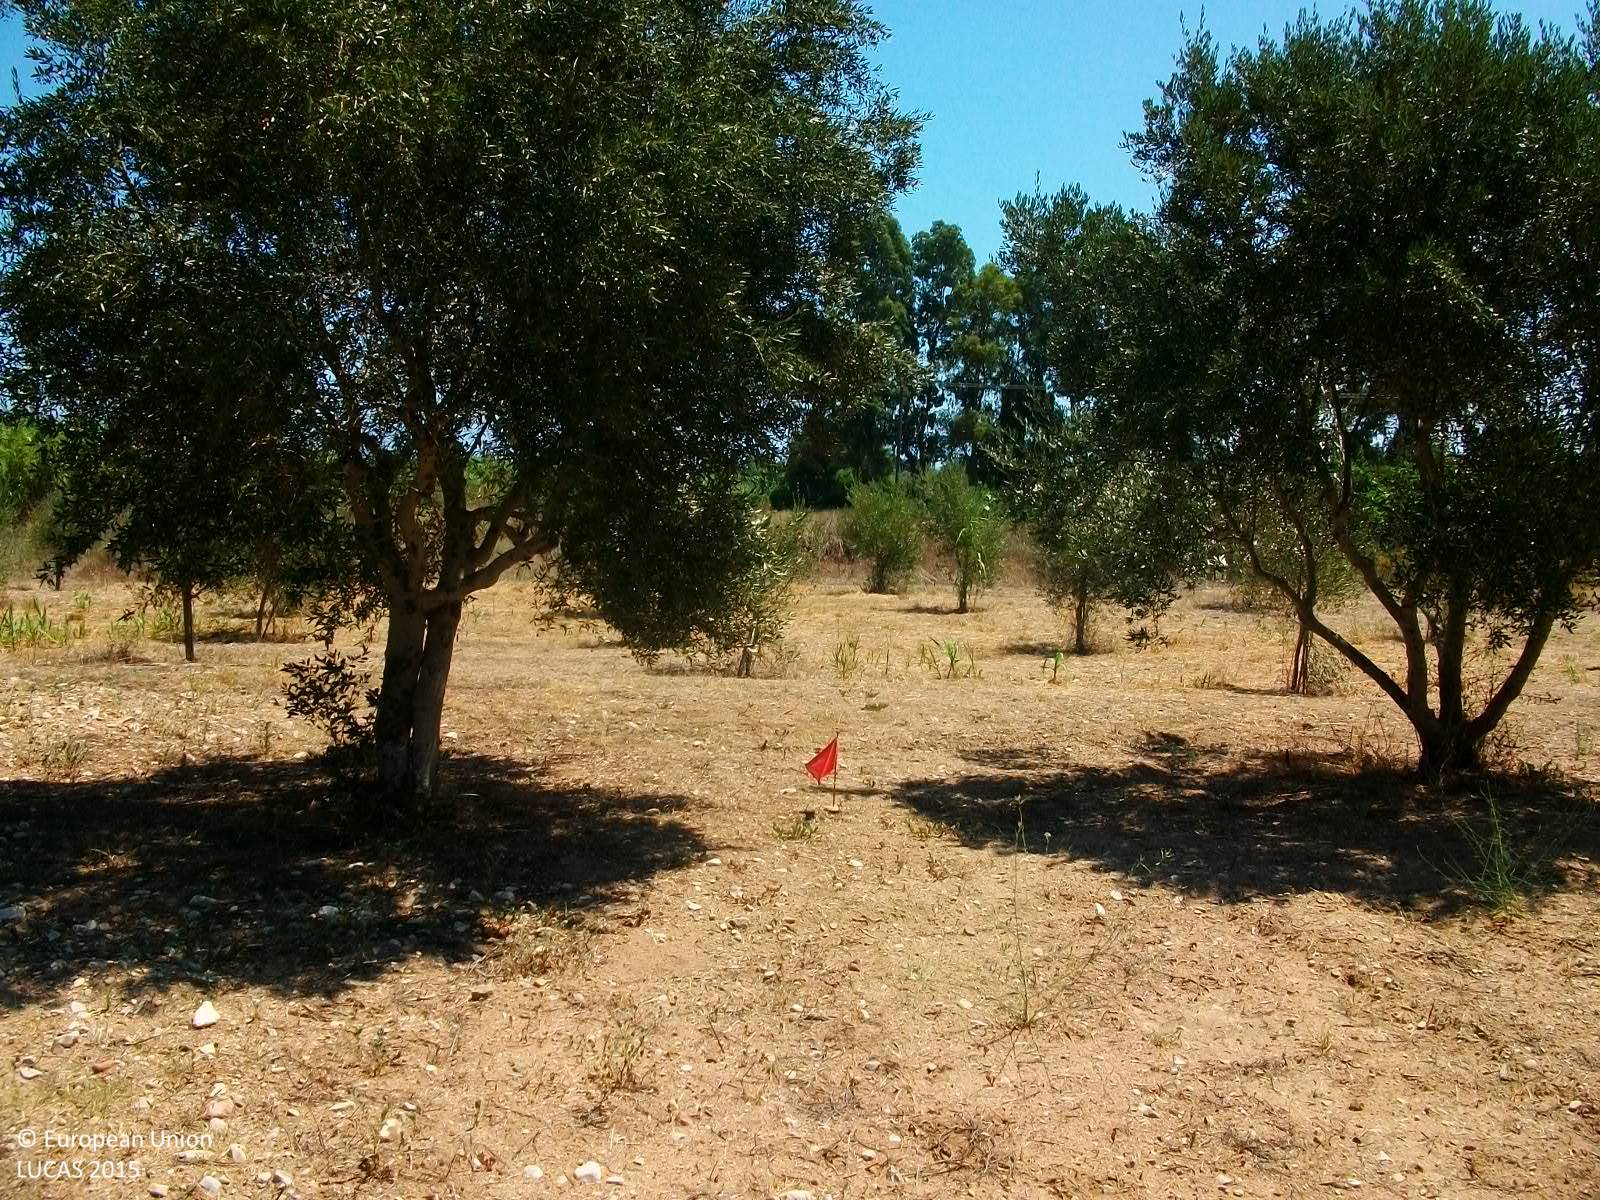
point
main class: Cropland
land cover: Olive groves
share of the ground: 10 - 25 %
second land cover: Spontaneously vegetated surfaces
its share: 10 - 25 %
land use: Agriculture (excluding fallow land and kitchen gardens)
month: July
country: GR
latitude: 36.8488
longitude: 21.9161
